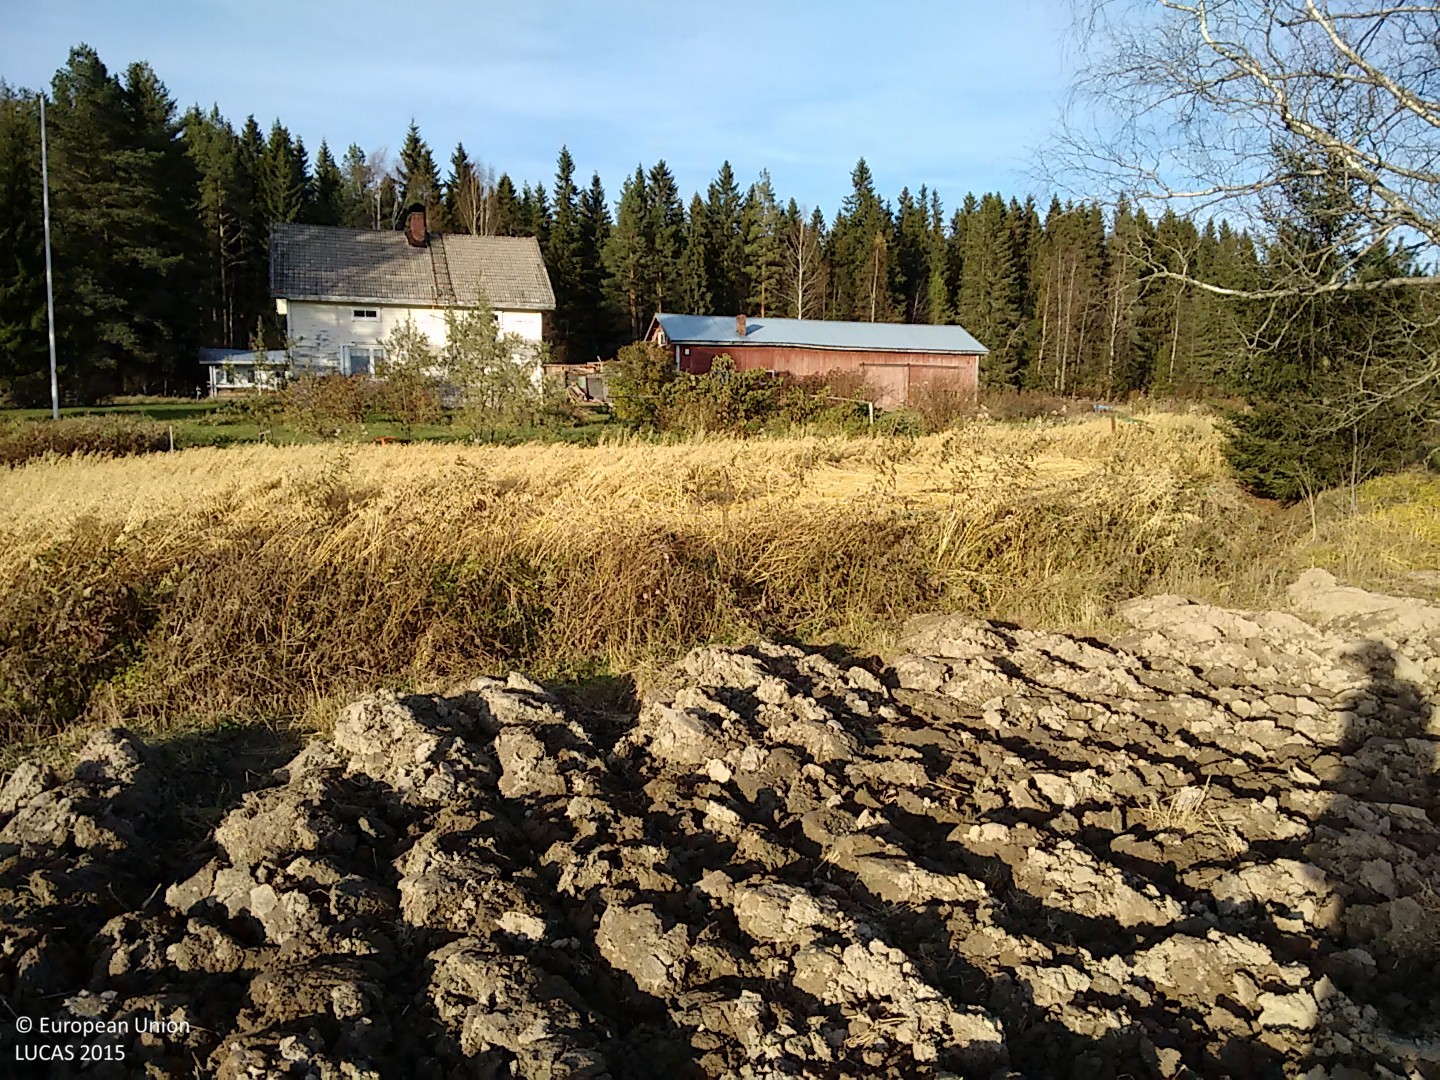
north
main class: Cropland
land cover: Barley
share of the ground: < 10 %
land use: Agriculture (excluding fallow land and kitchen gardens)
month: October
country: FI
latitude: 63.9615
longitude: 25.1360
